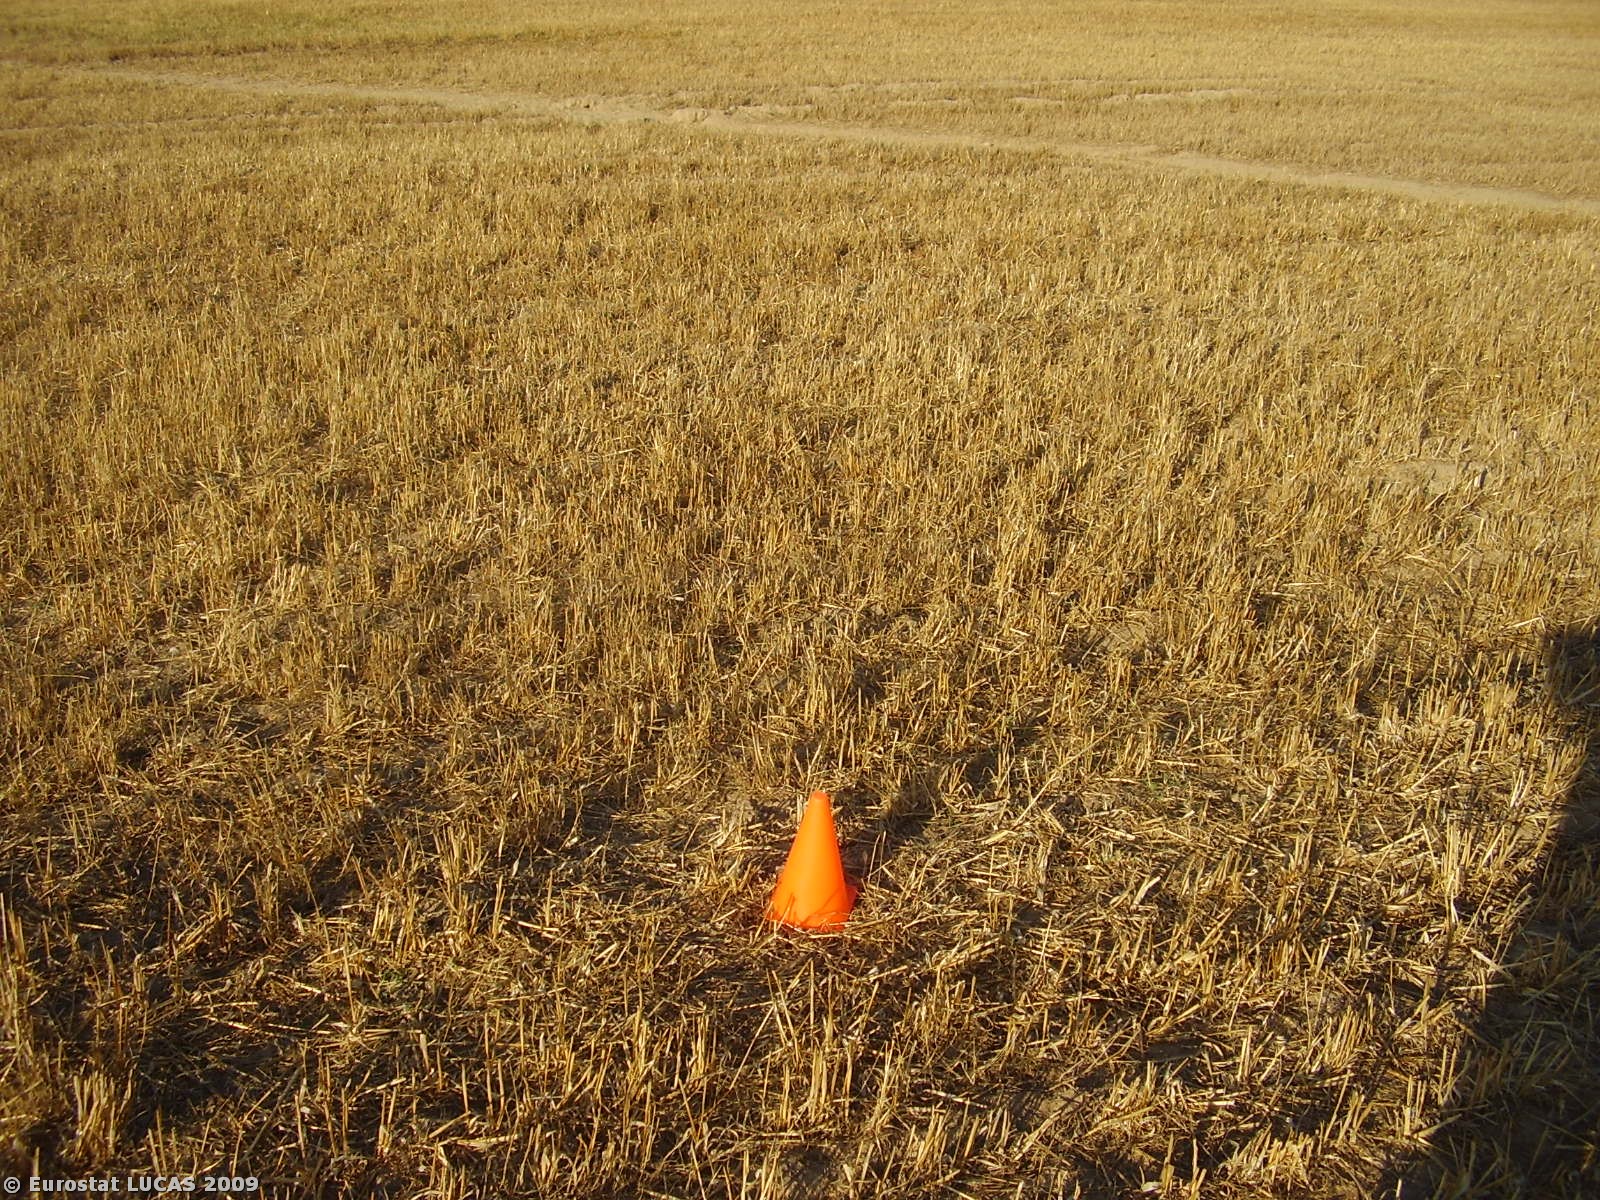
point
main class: Cropland
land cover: Oats
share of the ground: > 75 %
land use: Agriculture (excluding fallow land and kitchen gardens)
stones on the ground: 10 - 25 %
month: July
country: PT
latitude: 38.6192
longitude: -7.8293
